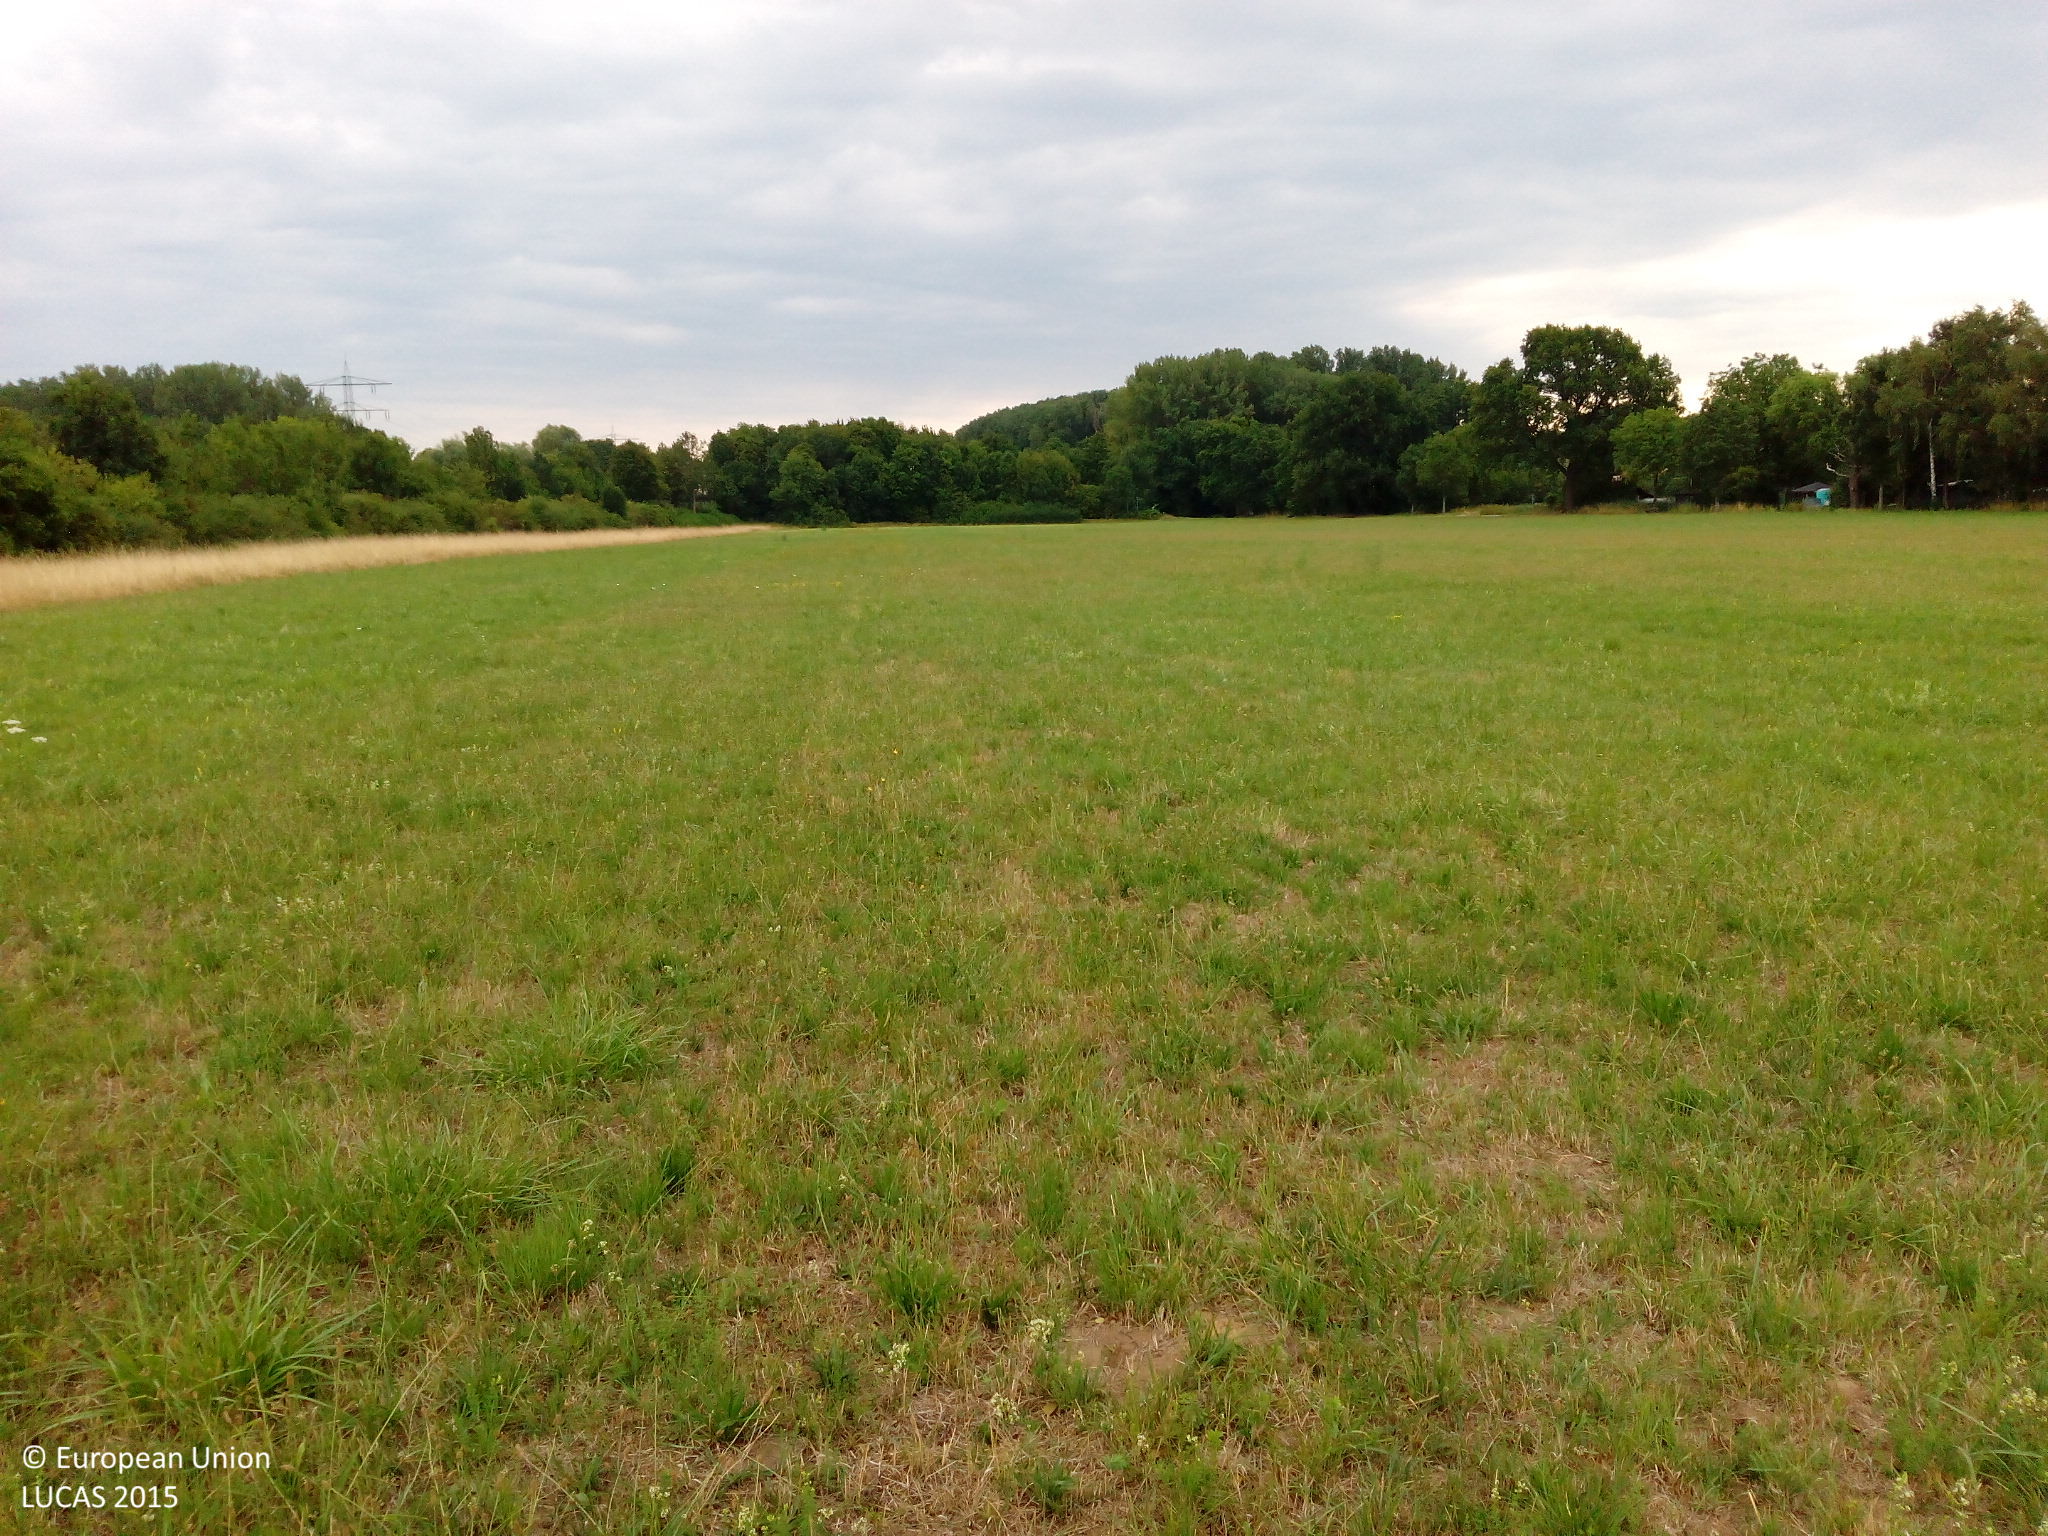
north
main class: Grassland
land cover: Grassland without tree/shrub cover
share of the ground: > 75 %
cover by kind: herbaceous plants 85 %, unconsolidated bare surface 15 %
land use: Agriculture (excluding fallow land and kitchen gardens)
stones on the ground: < 10 %
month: August
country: DE
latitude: 49.2771
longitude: 8.6672
